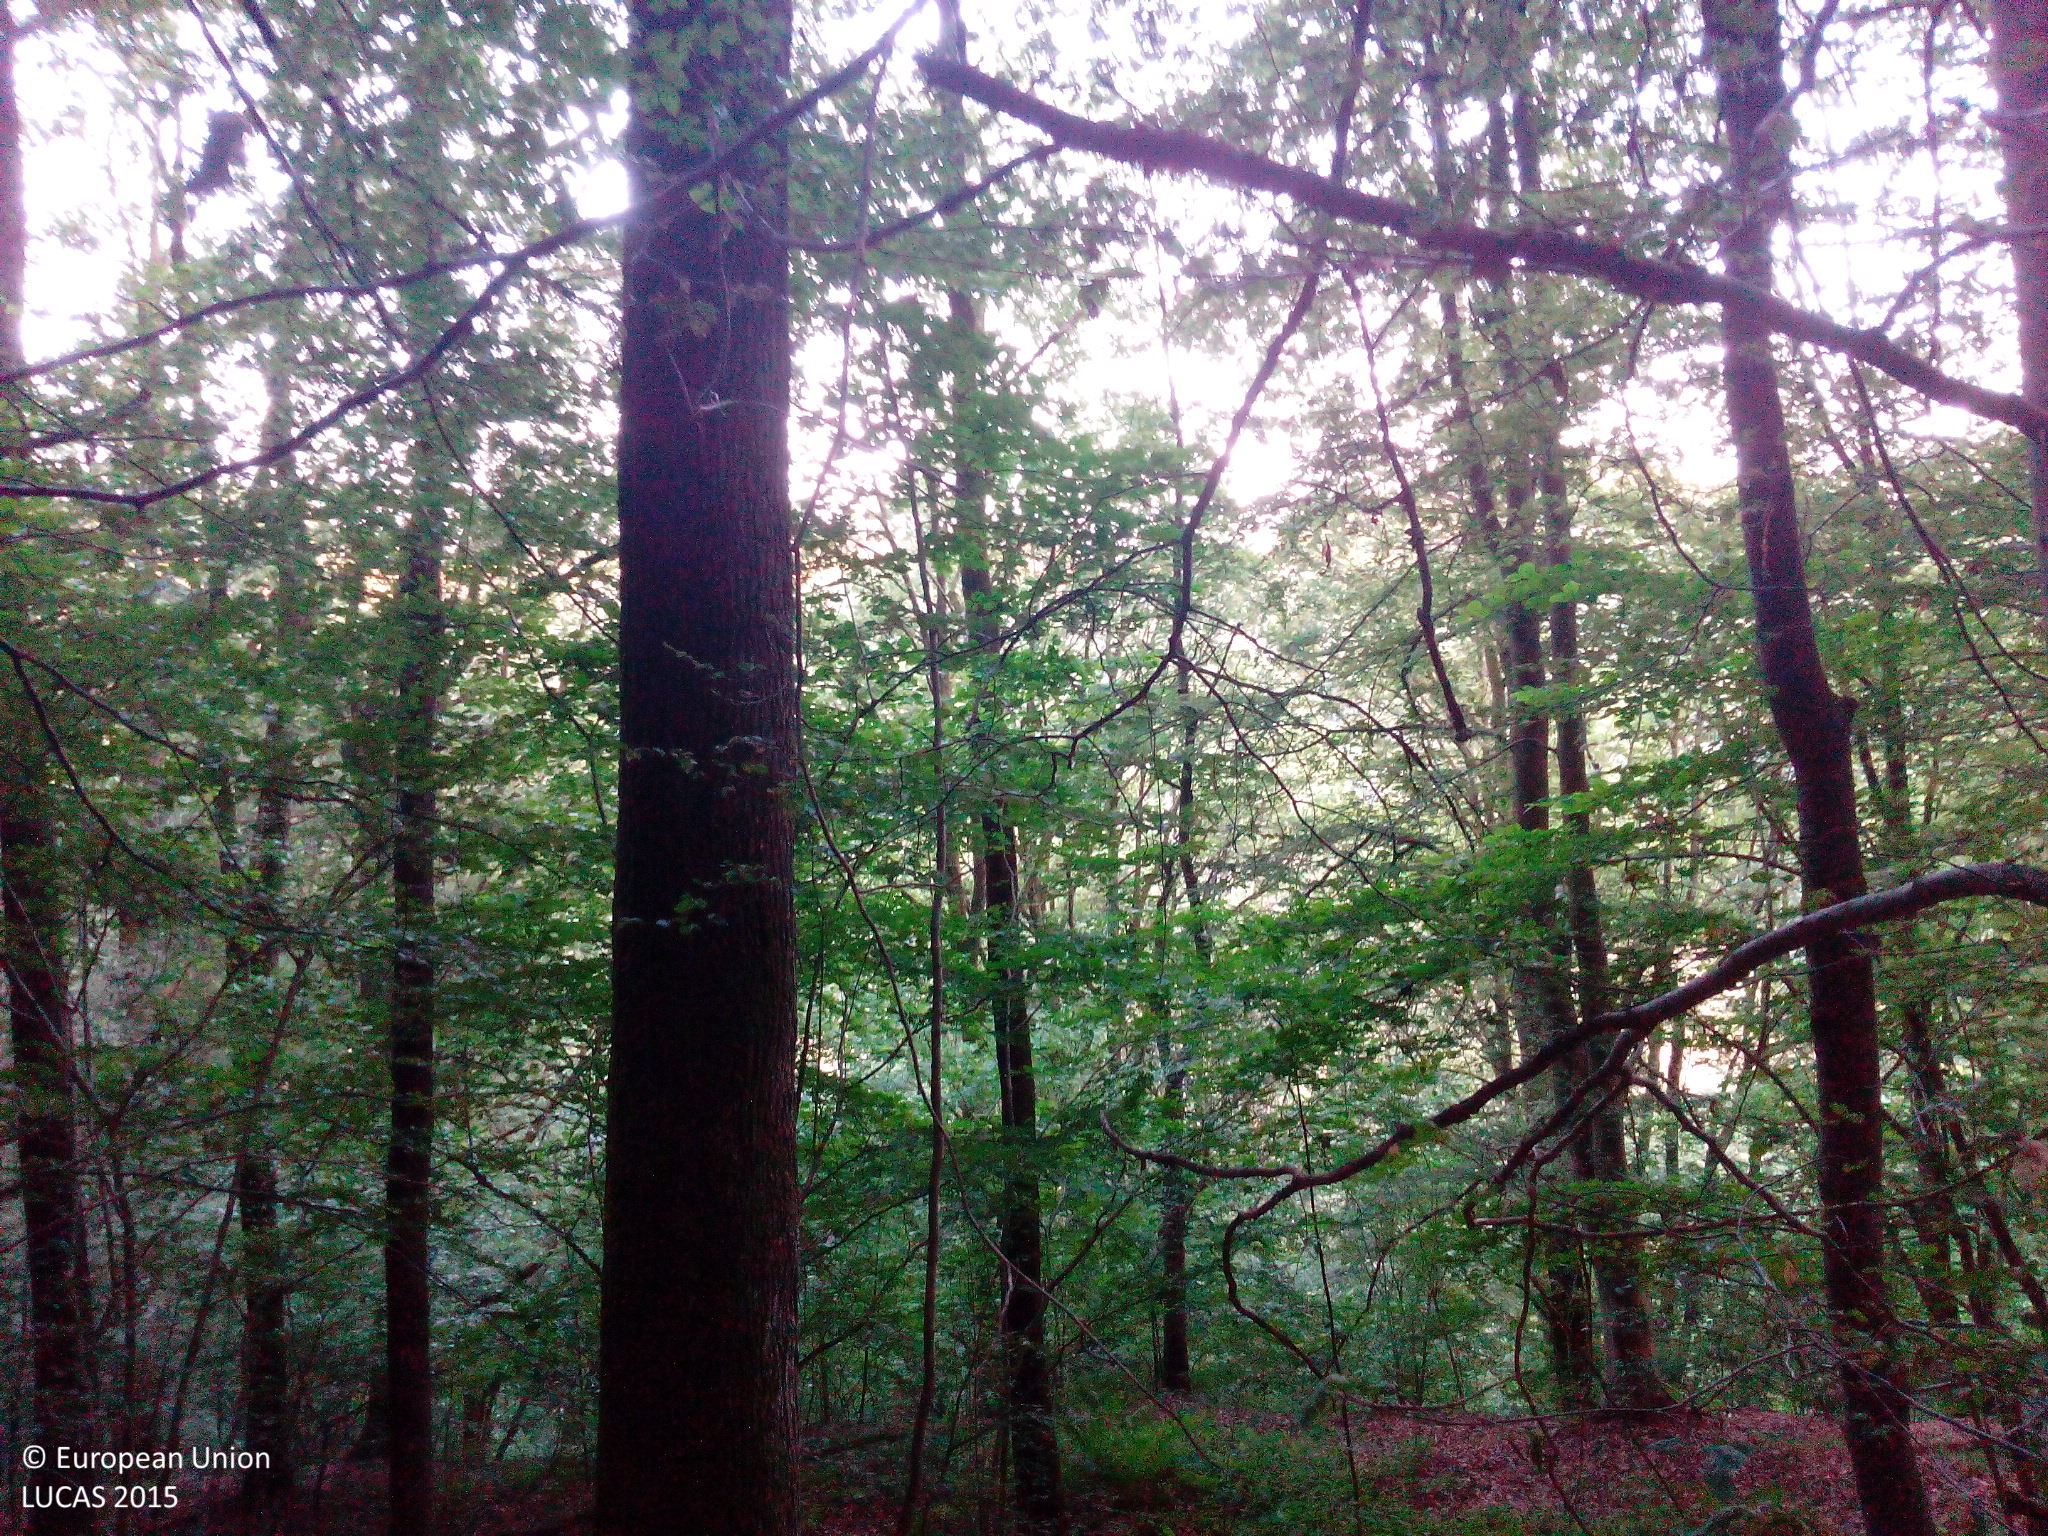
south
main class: Woodland
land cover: Broadleaved woodland
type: beech forest
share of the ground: > 75 %
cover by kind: broadleaved forest trees 90 %, unconsolidated bare surface 10 %
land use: Abandoned areas
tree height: > 5 m
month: July
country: DE
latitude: 49.1329
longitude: 7.5747
